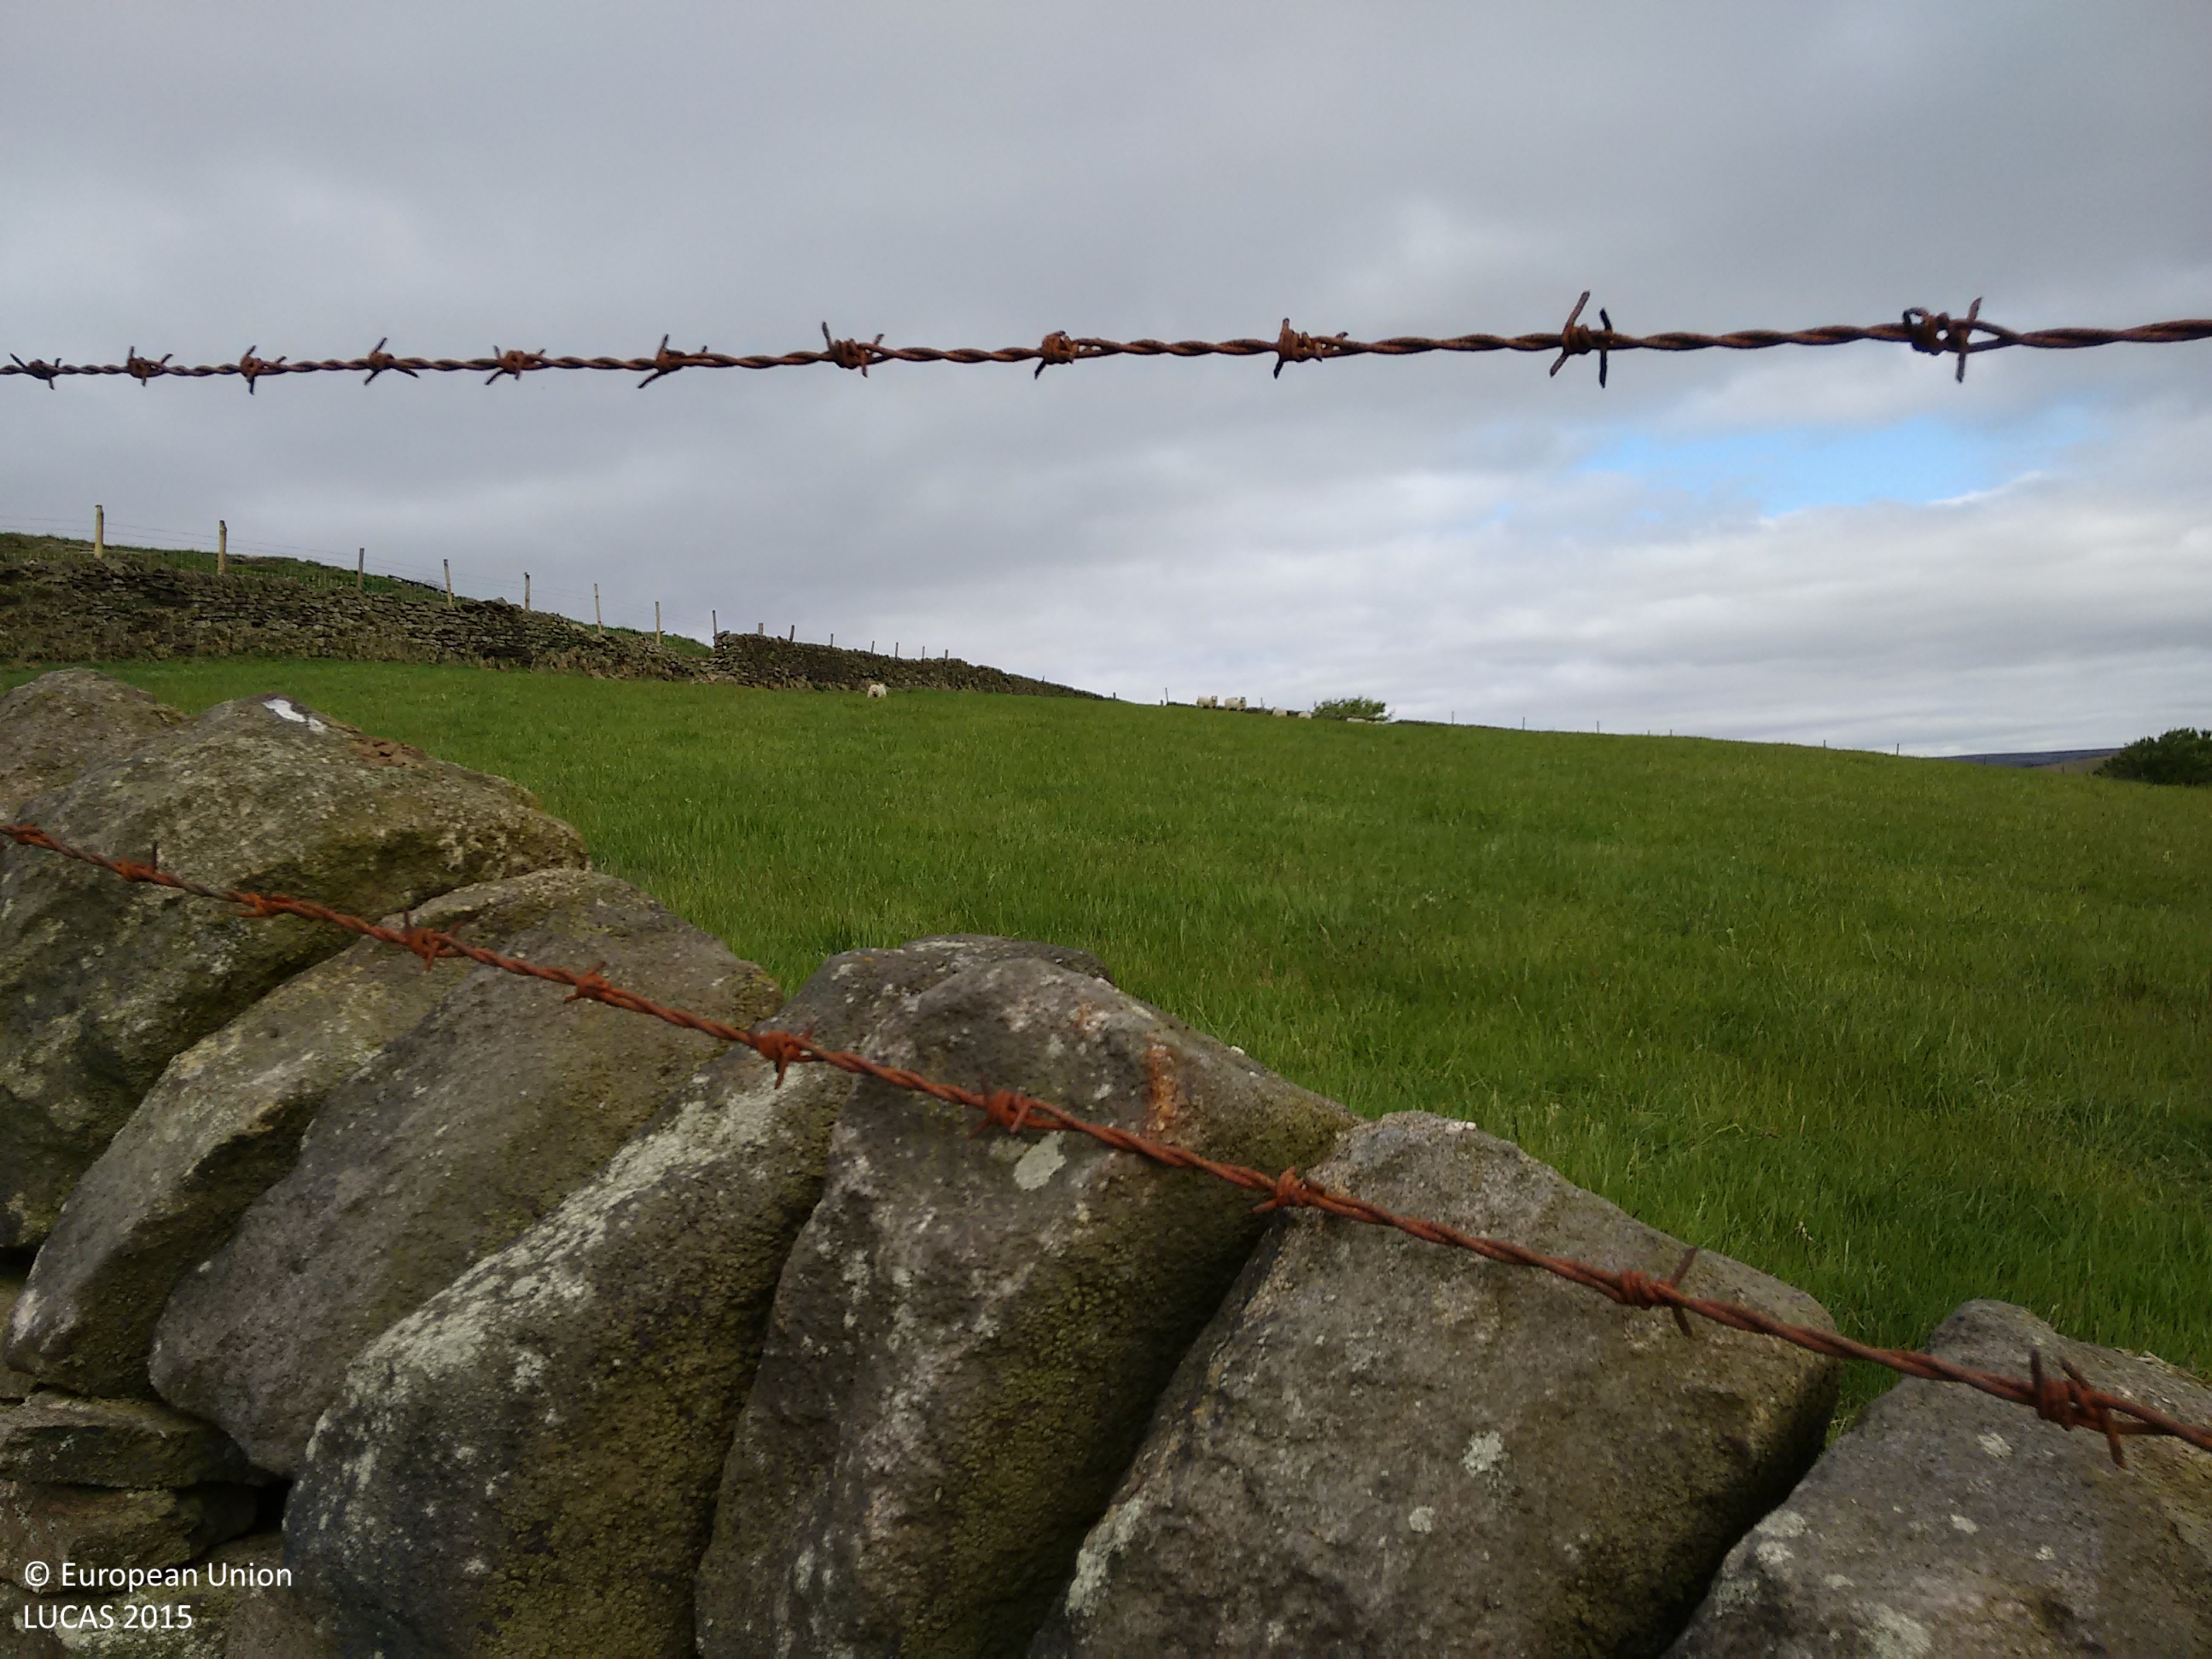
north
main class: Grassland
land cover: Grassland without tree/shrub cover
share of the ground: > 75 %
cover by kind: herbaceous plants 100 %
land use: Agriculture (excluding fallow land and kitchen gardens)
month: May
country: GB
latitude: 53.4038
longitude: -1.6187
